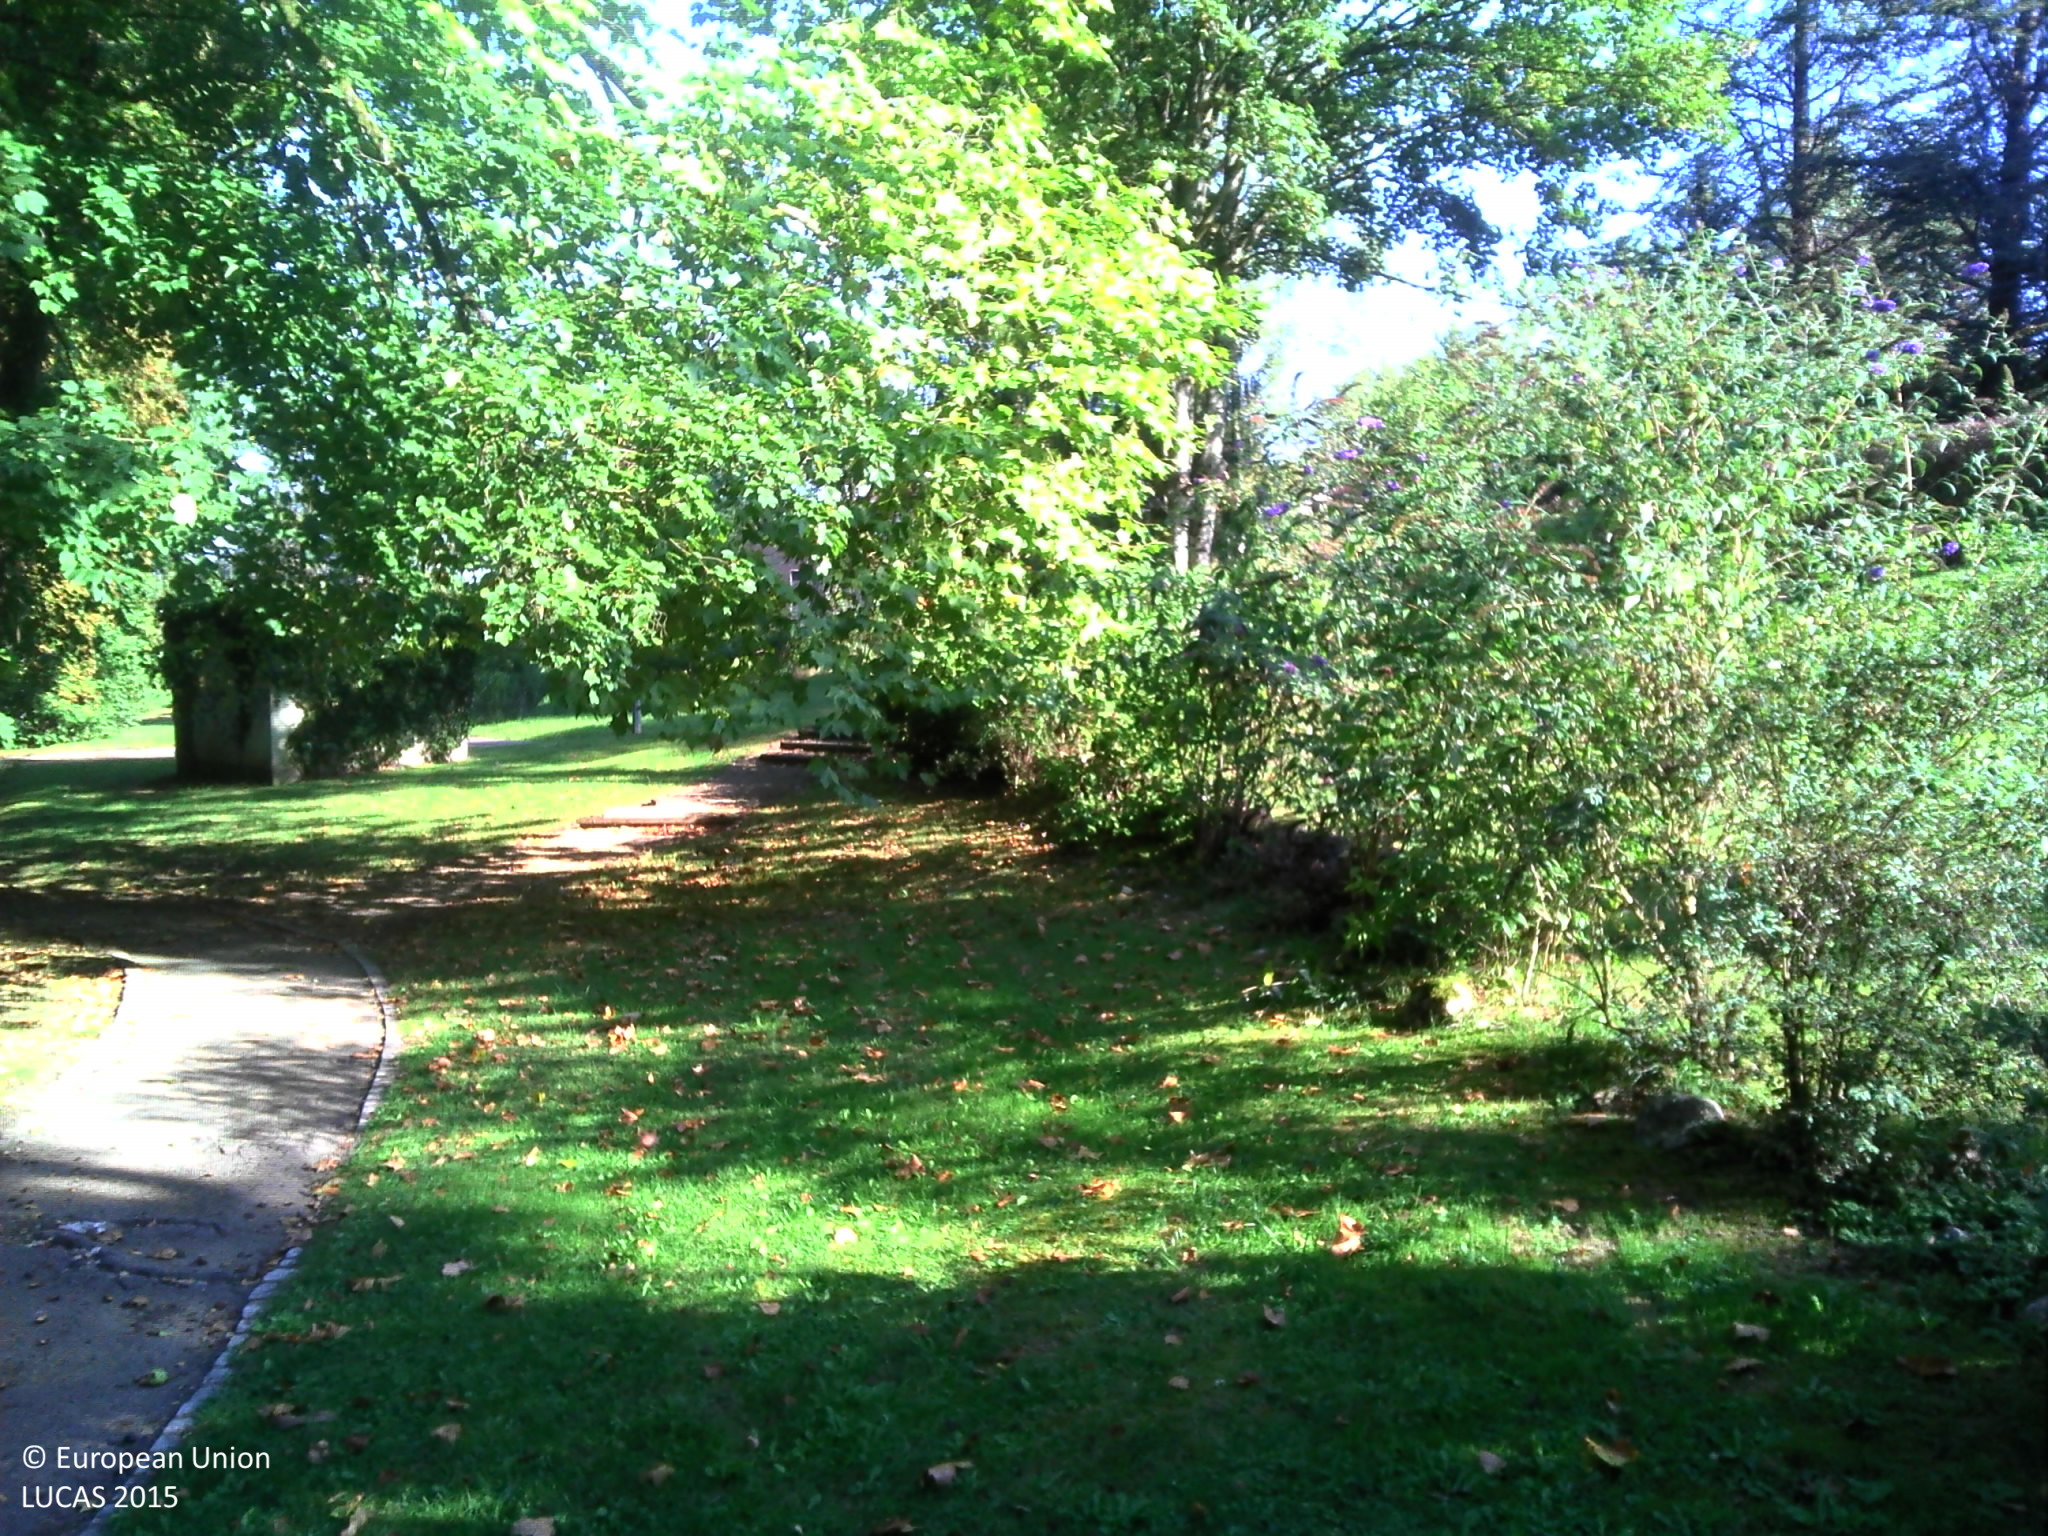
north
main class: Grassland
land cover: Grassland without tree/shrub cover
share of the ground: > 75 %
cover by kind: herbaceous plants 70 %, consolidated bare surface 10 %
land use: Amenities, museums, leisure
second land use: Sport
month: September
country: FR
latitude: 47.3228
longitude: 6.0191
